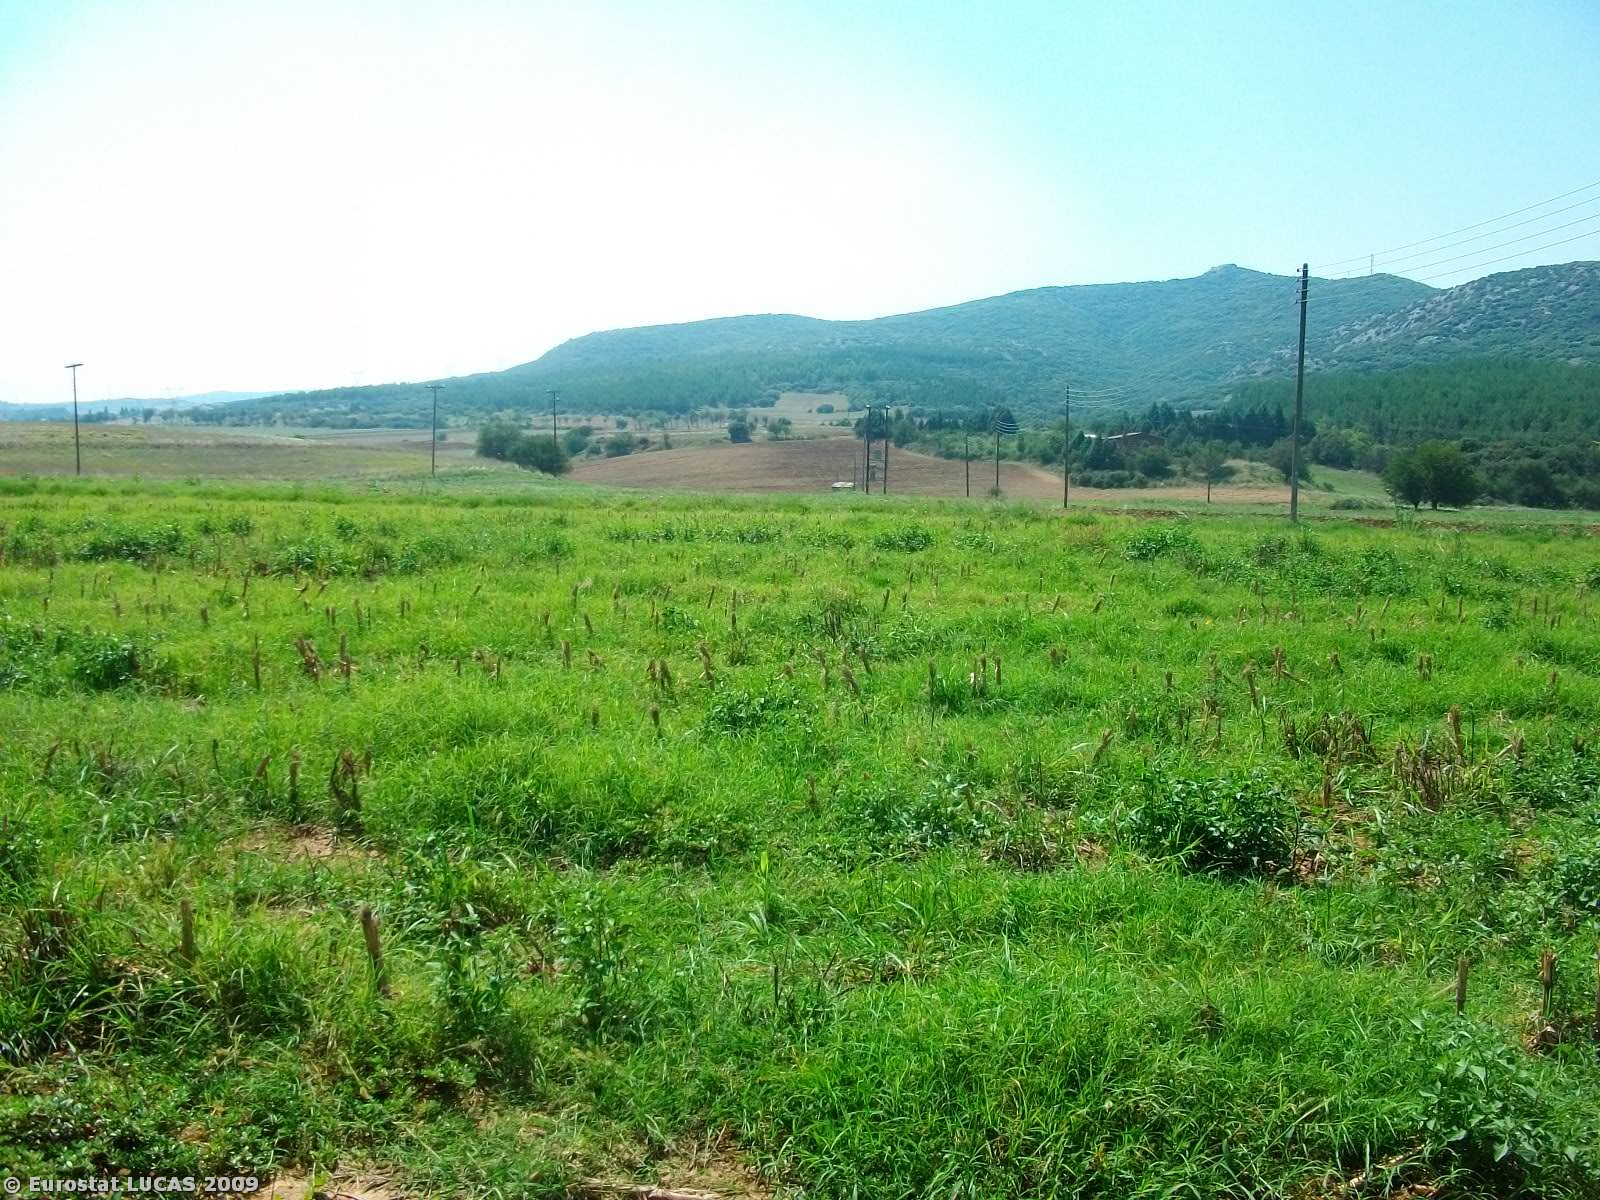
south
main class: Cropland
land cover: Maize
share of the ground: < 10 %
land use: Agriculture (excluding fallow land and kitchen gardens)
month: August
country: GR
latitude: 40.8207
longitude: 22.8967
